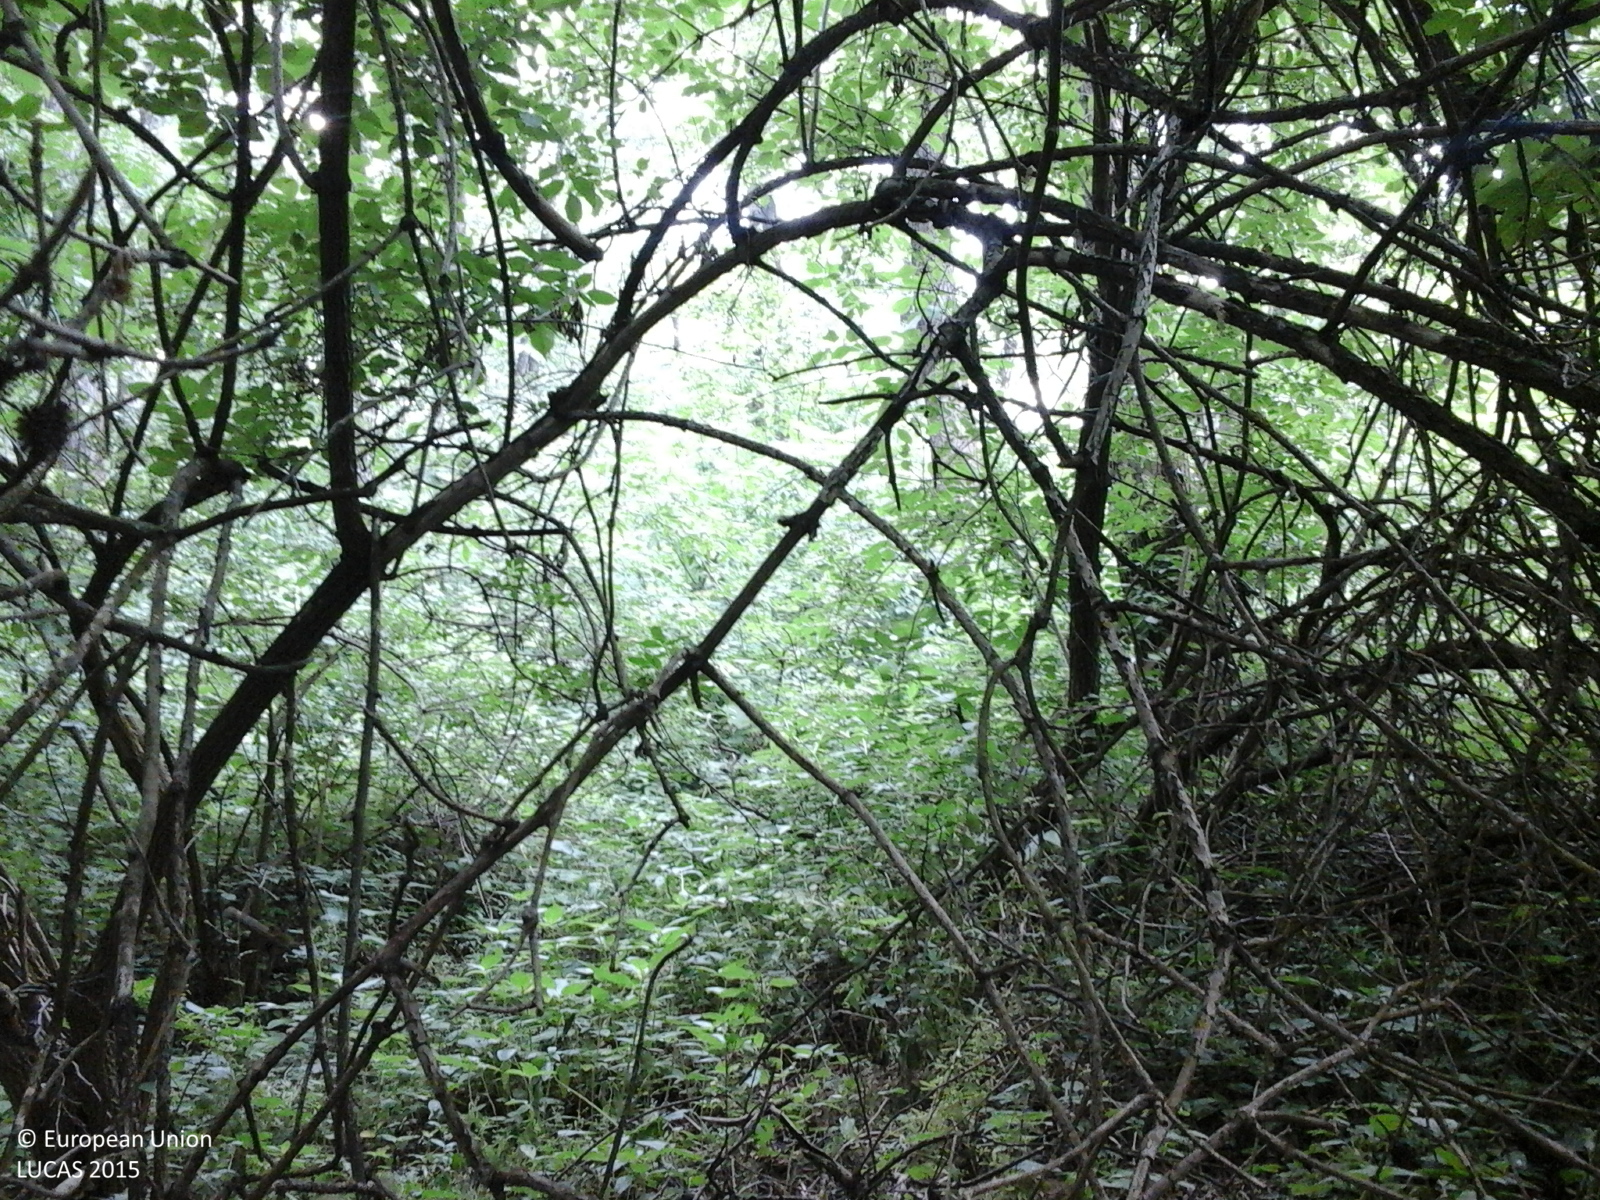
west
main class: Woodland
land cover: Broadleaved woodland
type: non-riverine alder, birch or aspen forest
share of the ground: > 75 %
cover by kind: broadleaved forest trees 100 %
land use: Forestry
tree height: > 5 m
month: June
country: RO
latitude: 47.4806
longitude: 26.3952
